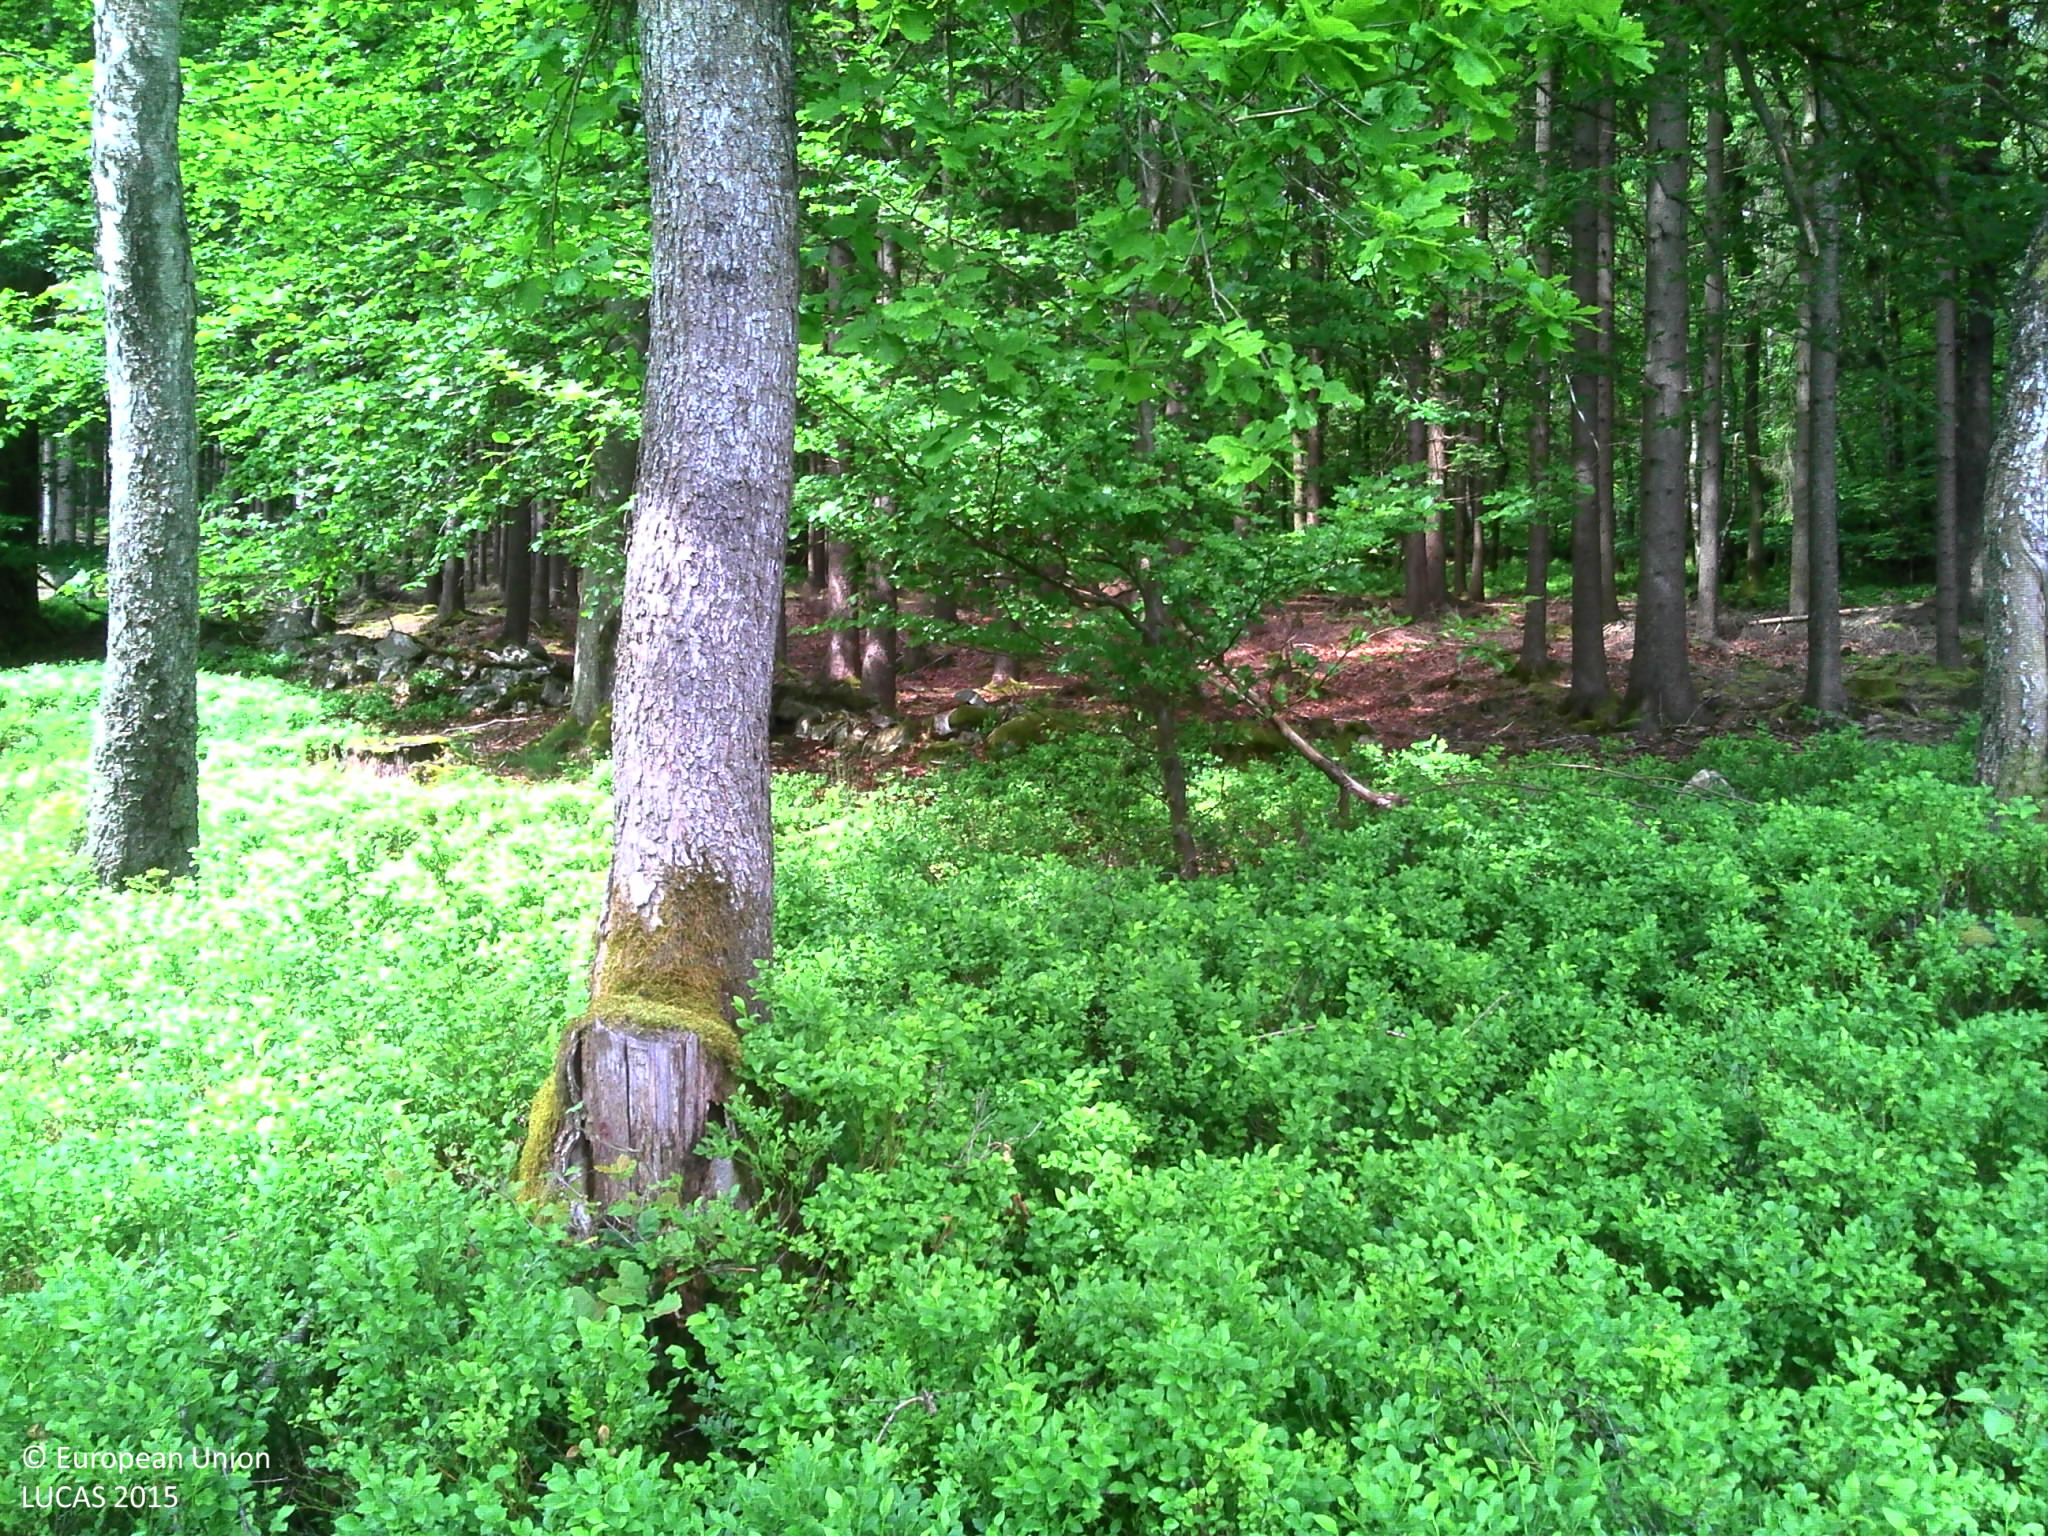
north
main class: Shrubland
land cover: Shrubland without tree cover
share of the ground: > 75 %
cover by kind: herbaceous plants 45 %, shrubs 25 %, unconsolidated bare surface 15 %
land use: Forestry
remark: Clear cut
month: June
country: BE
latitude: 50.3578
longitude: 5.7678
